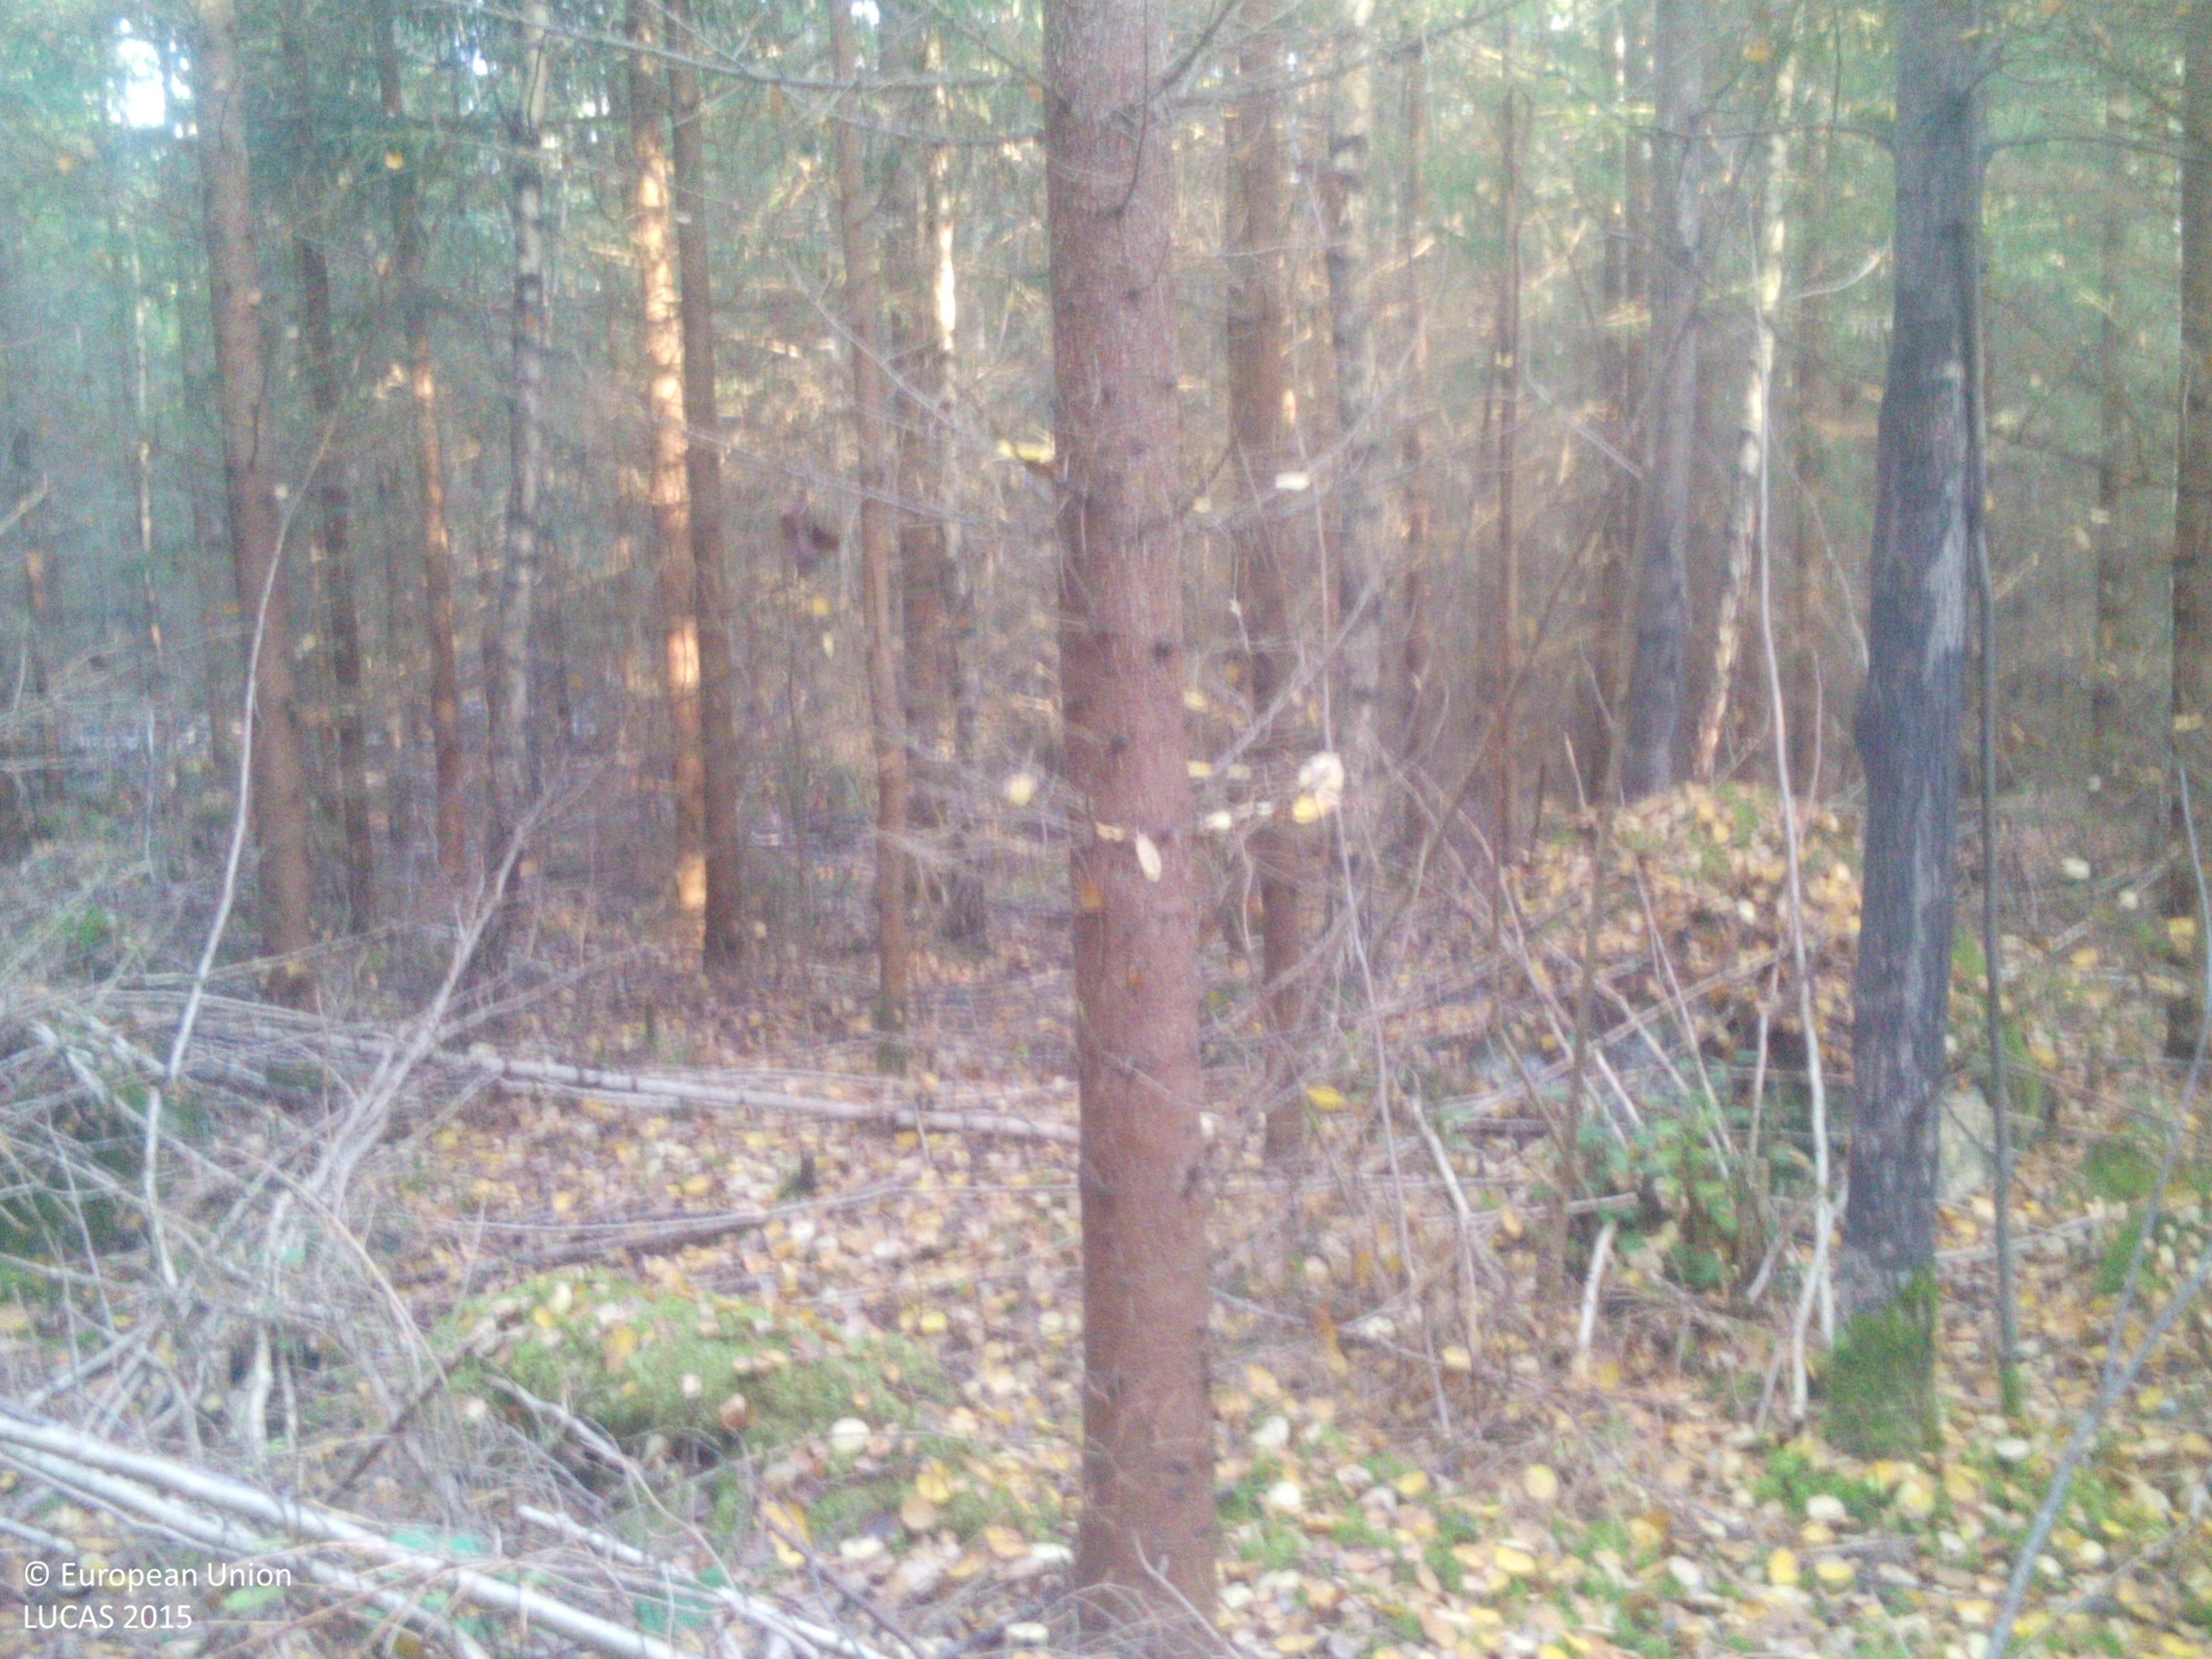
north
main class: Woodland
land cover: Spruce dominated mixed woodland
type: boreal forest
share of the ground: > 75 %
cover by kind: coniferous forest trees 55 %, broadleaved forest trees 40 %, lichens and mosses 5 %
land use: Forestry
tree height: > 5 m
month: October
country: SE
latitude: 58.8943
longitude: 16.4678
